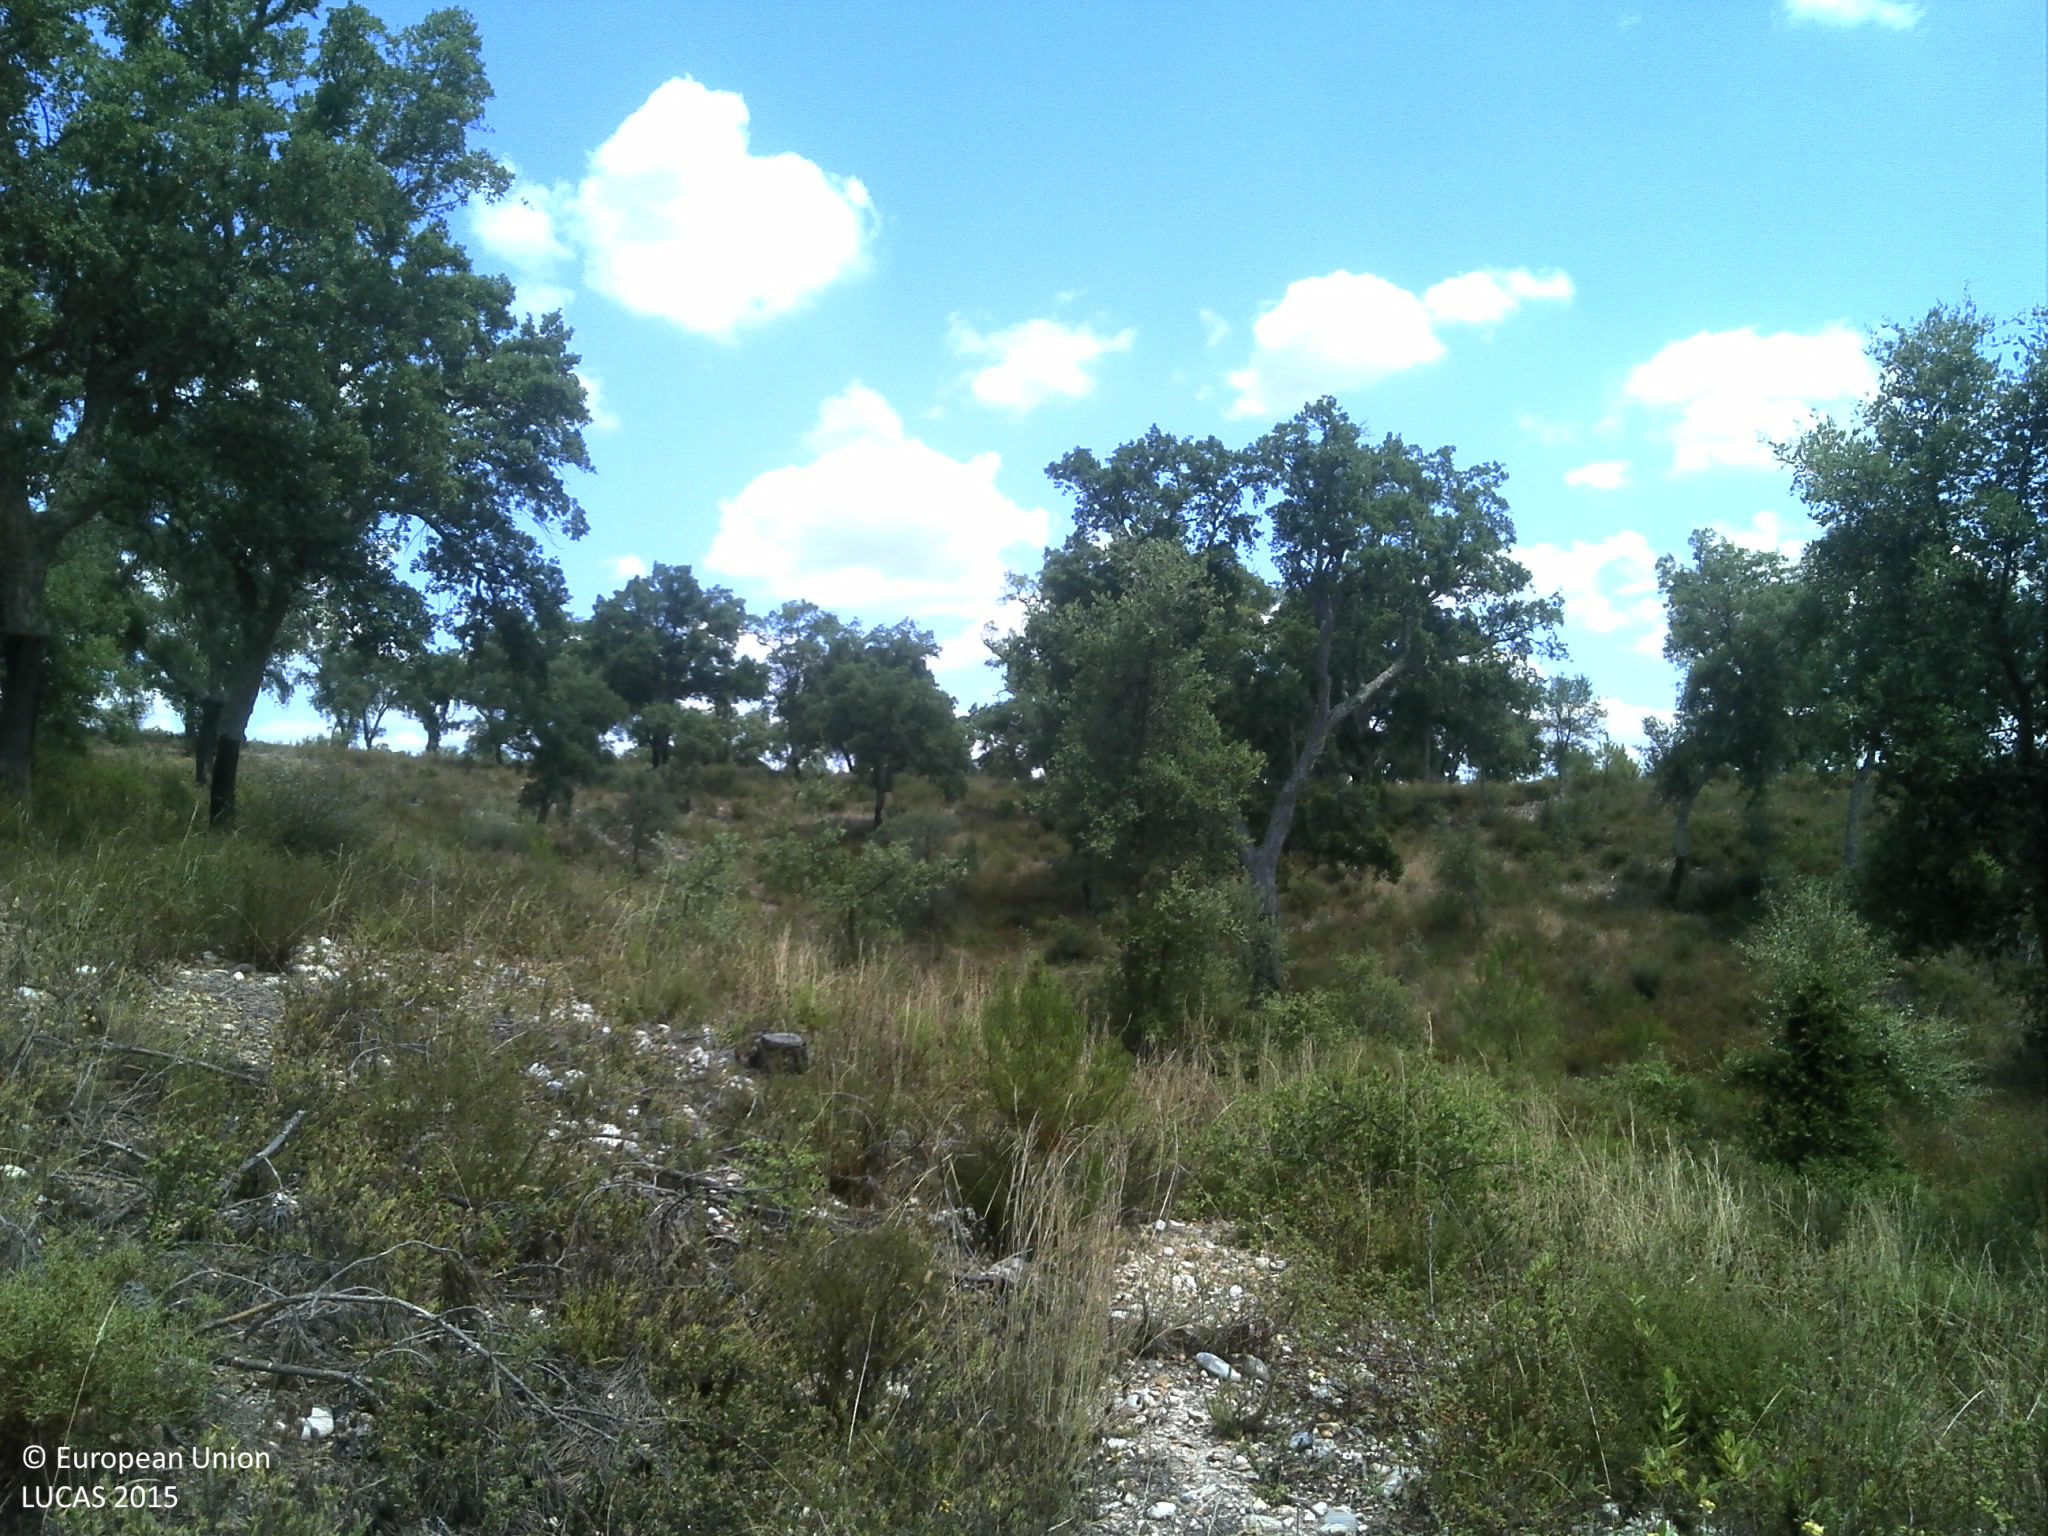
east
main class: Woodland
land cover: Broadleaved woodland
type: broadleaved evergreen forest
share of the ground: 10 - 25 %
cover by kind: unconsolidated bare surface 40 %, broadleaved forest trees 25 %, shrubs 25 %, herbaceous plants 10 %
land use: Forestry
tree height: > 5 m
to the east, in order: Broadleaved woodland; Shrubland without tree cover; Tracks; Broadleaved woodland; Rivers and streams; Broadleaved woodland
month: June
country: PT
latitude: 39.2745
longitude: -8.2726
